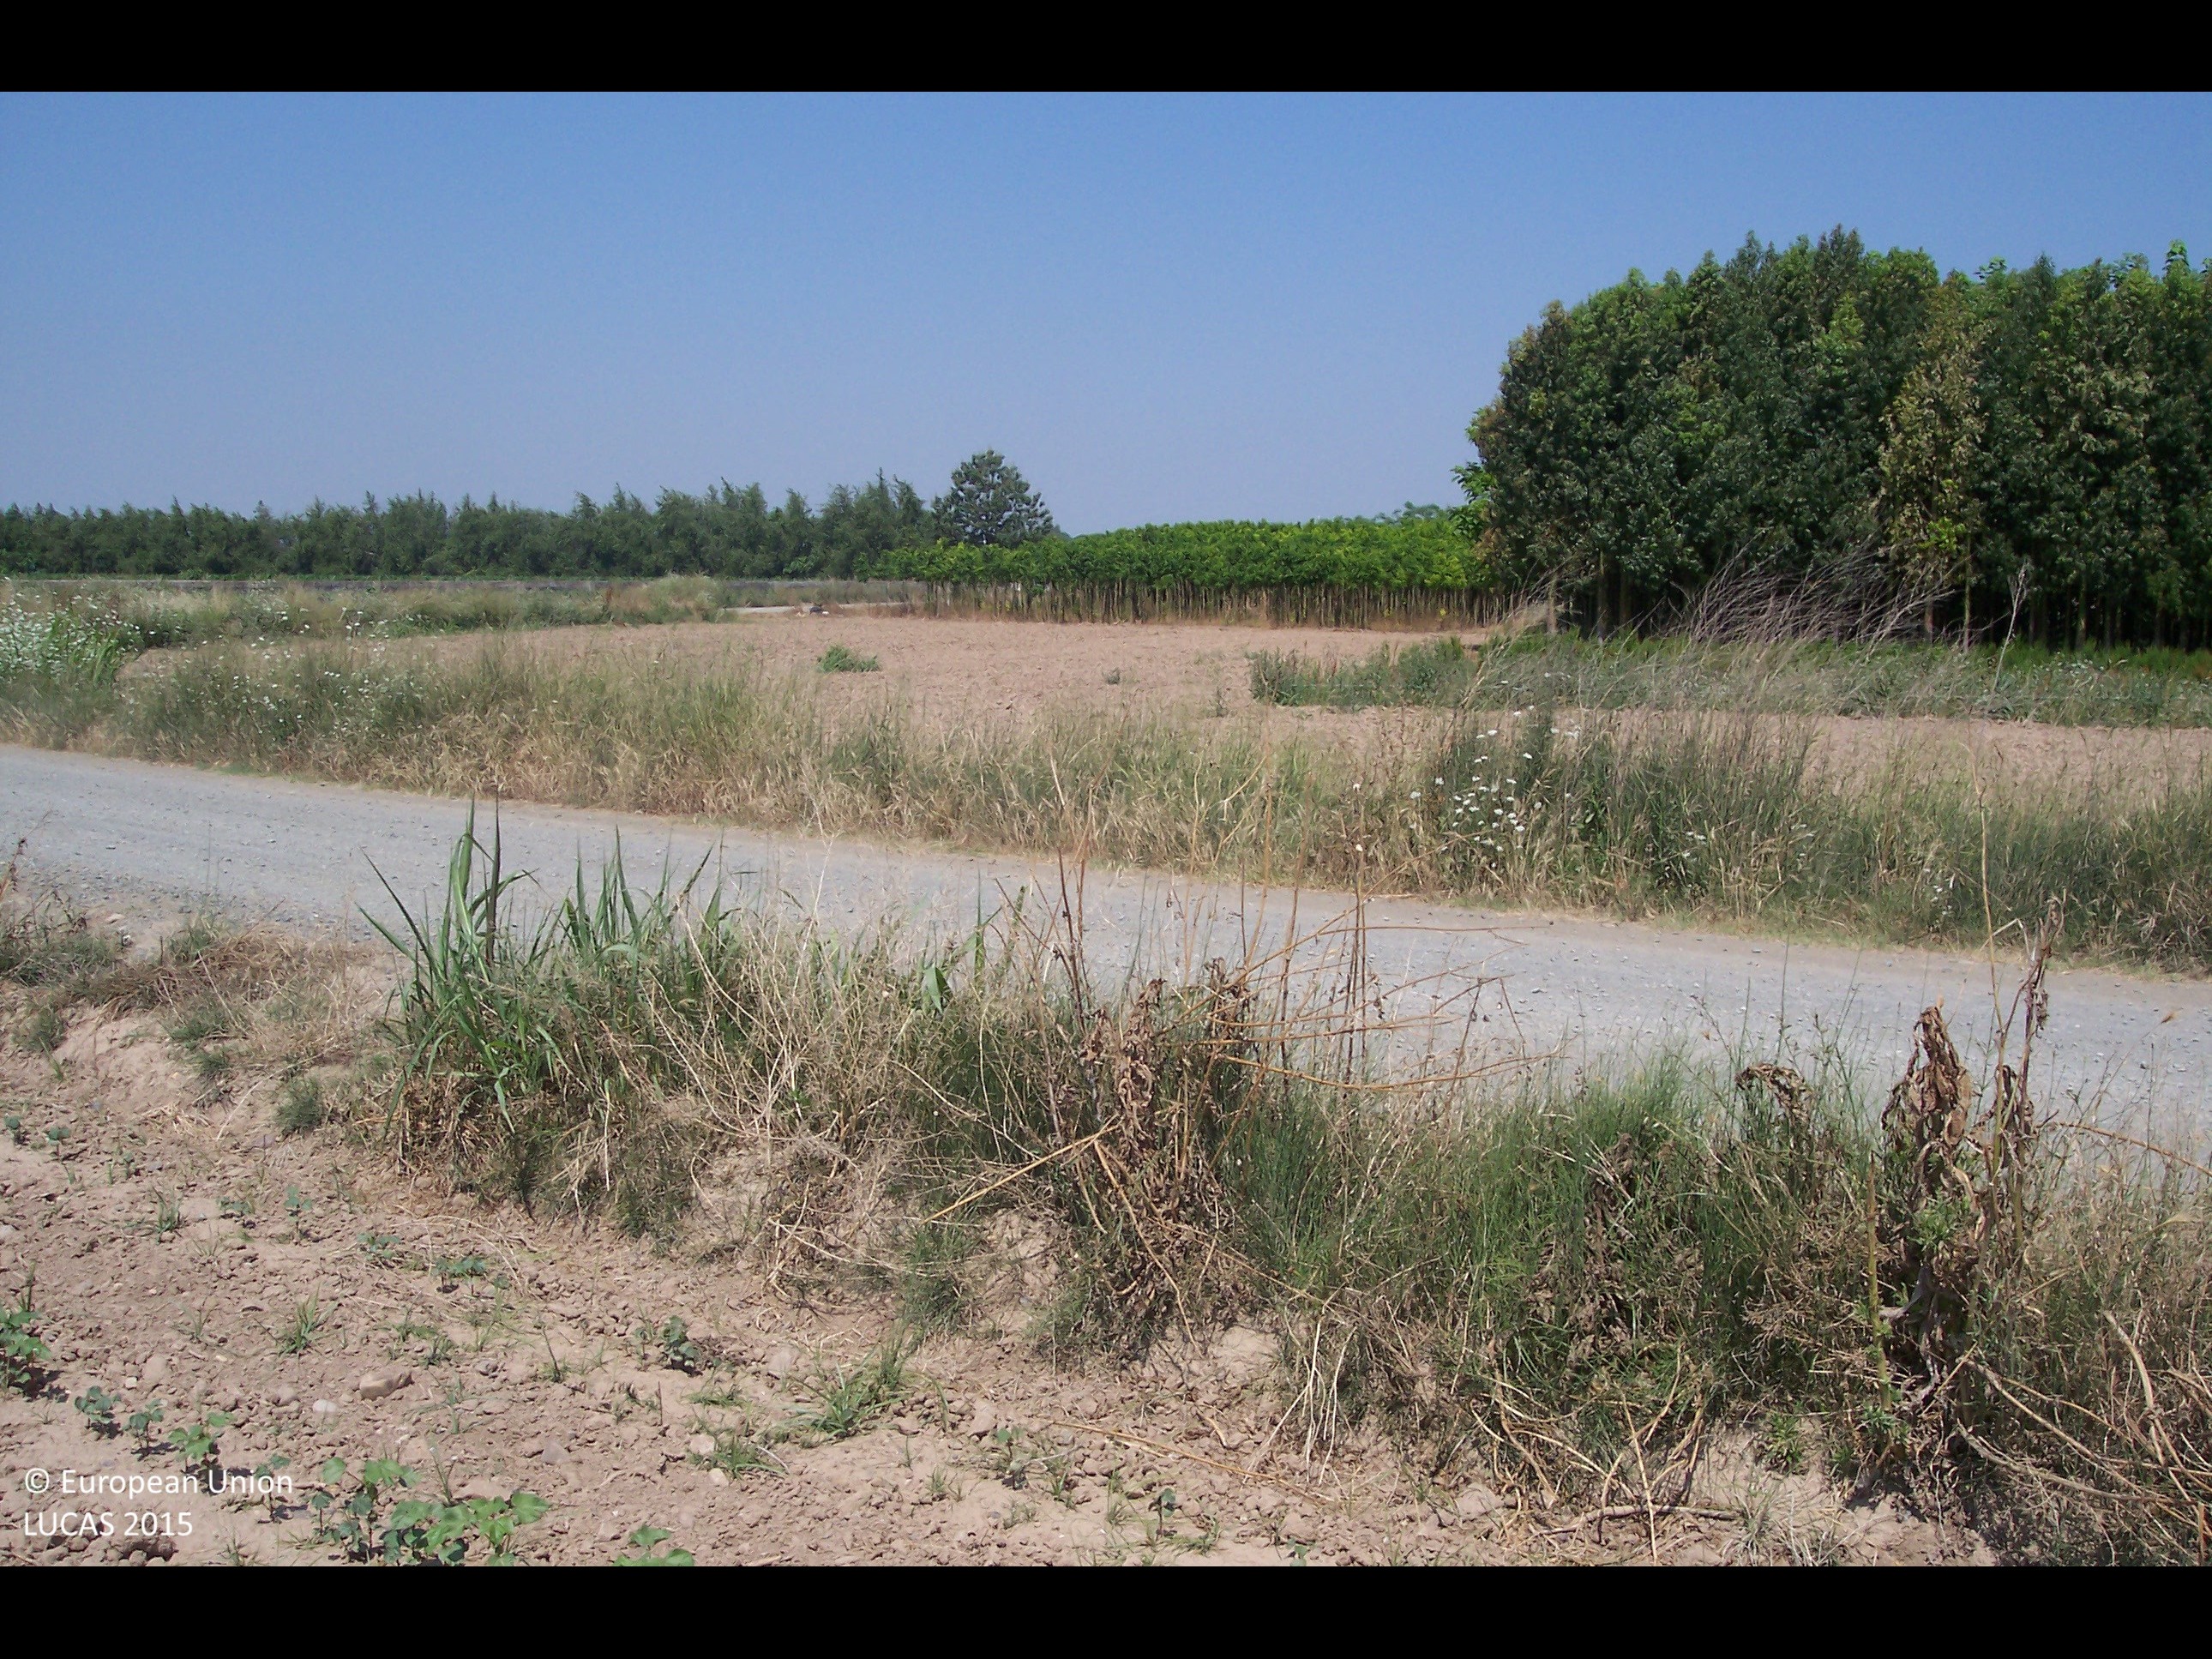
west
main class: Cropland
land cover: Cotton
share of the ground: < 10 %
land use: Agriculture (excluding fallow land and kitchen gardens)
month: May
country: ES
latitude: 37.5389
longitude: -5.9264
